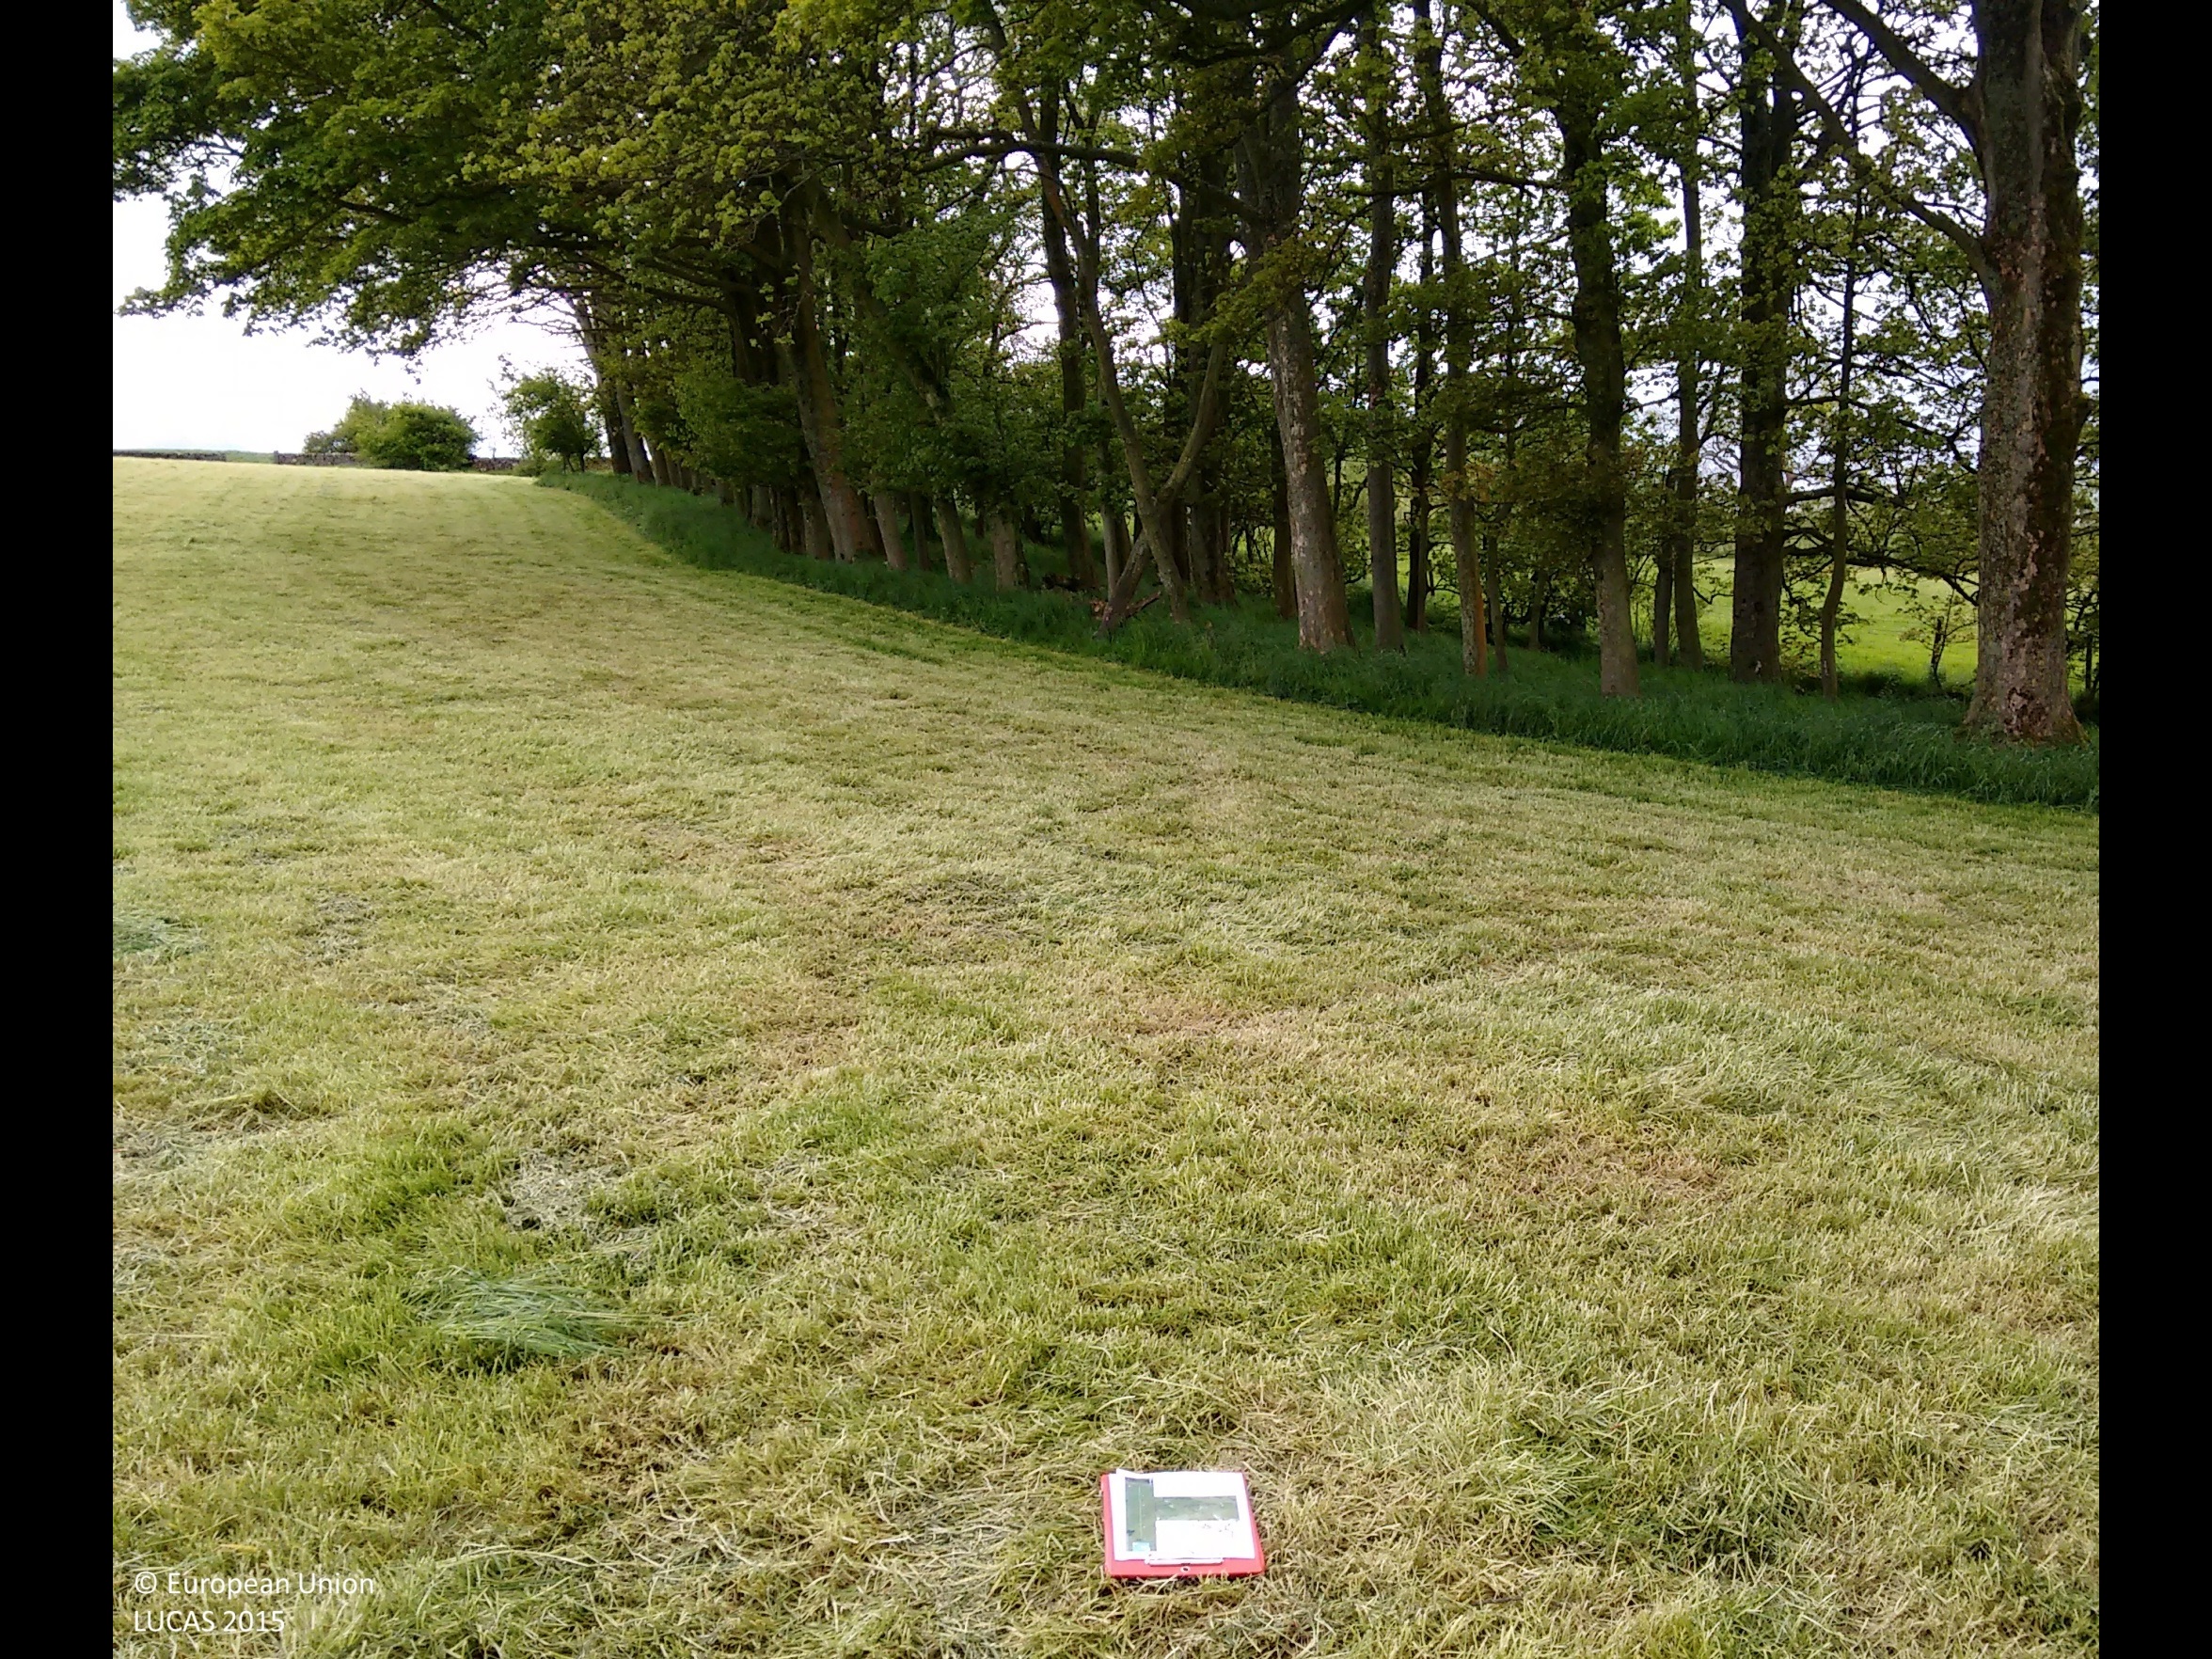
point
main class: Grassland
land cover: Grassland without tree/shrub cover
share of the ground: > 75 %
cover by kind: herbaceous plants 100 %
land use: Agriculture (excluding fallow land and kitchen gardens)
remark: Harvested field
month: May
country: GB
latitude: 54.0231
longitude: -2.1637
